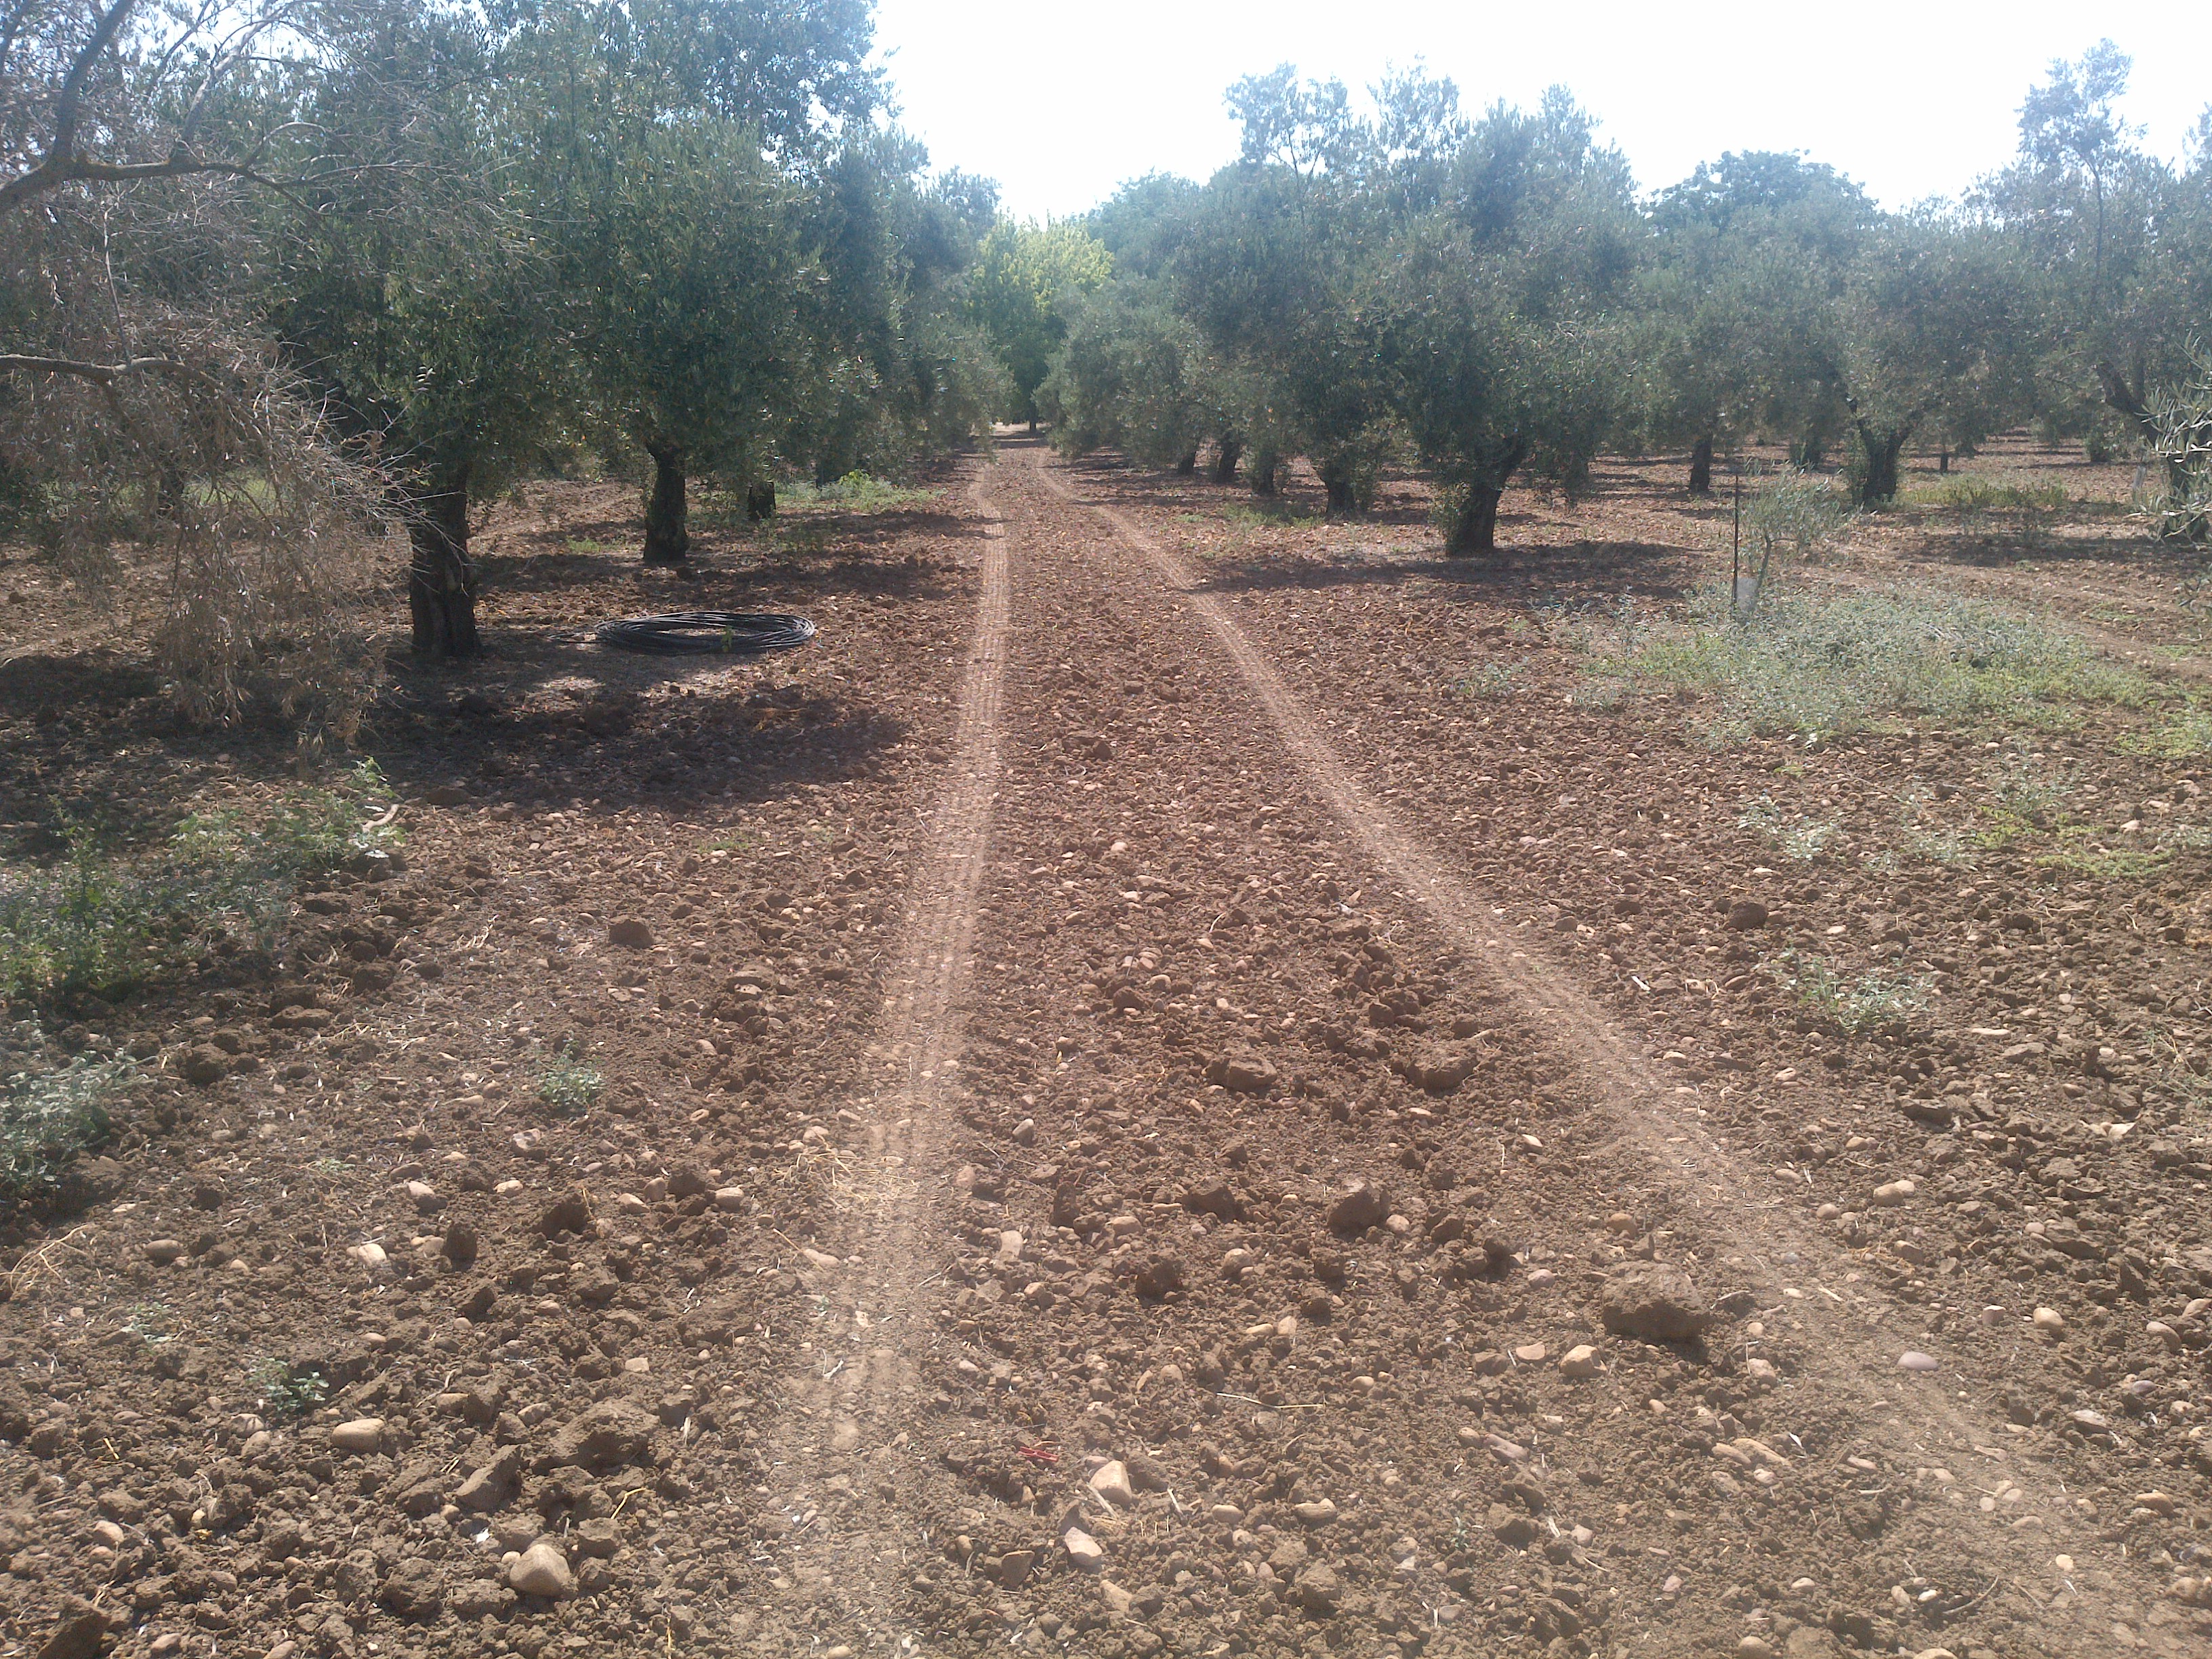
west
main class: Cropland
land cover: Olive groves
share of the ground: 50 - 75 %
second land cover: Other bare soil
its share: > 75 %
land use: Agriculture (excluding fallow land and kitchen gardens)
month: June
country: ES
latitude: 37.5854
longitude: -4.8567
